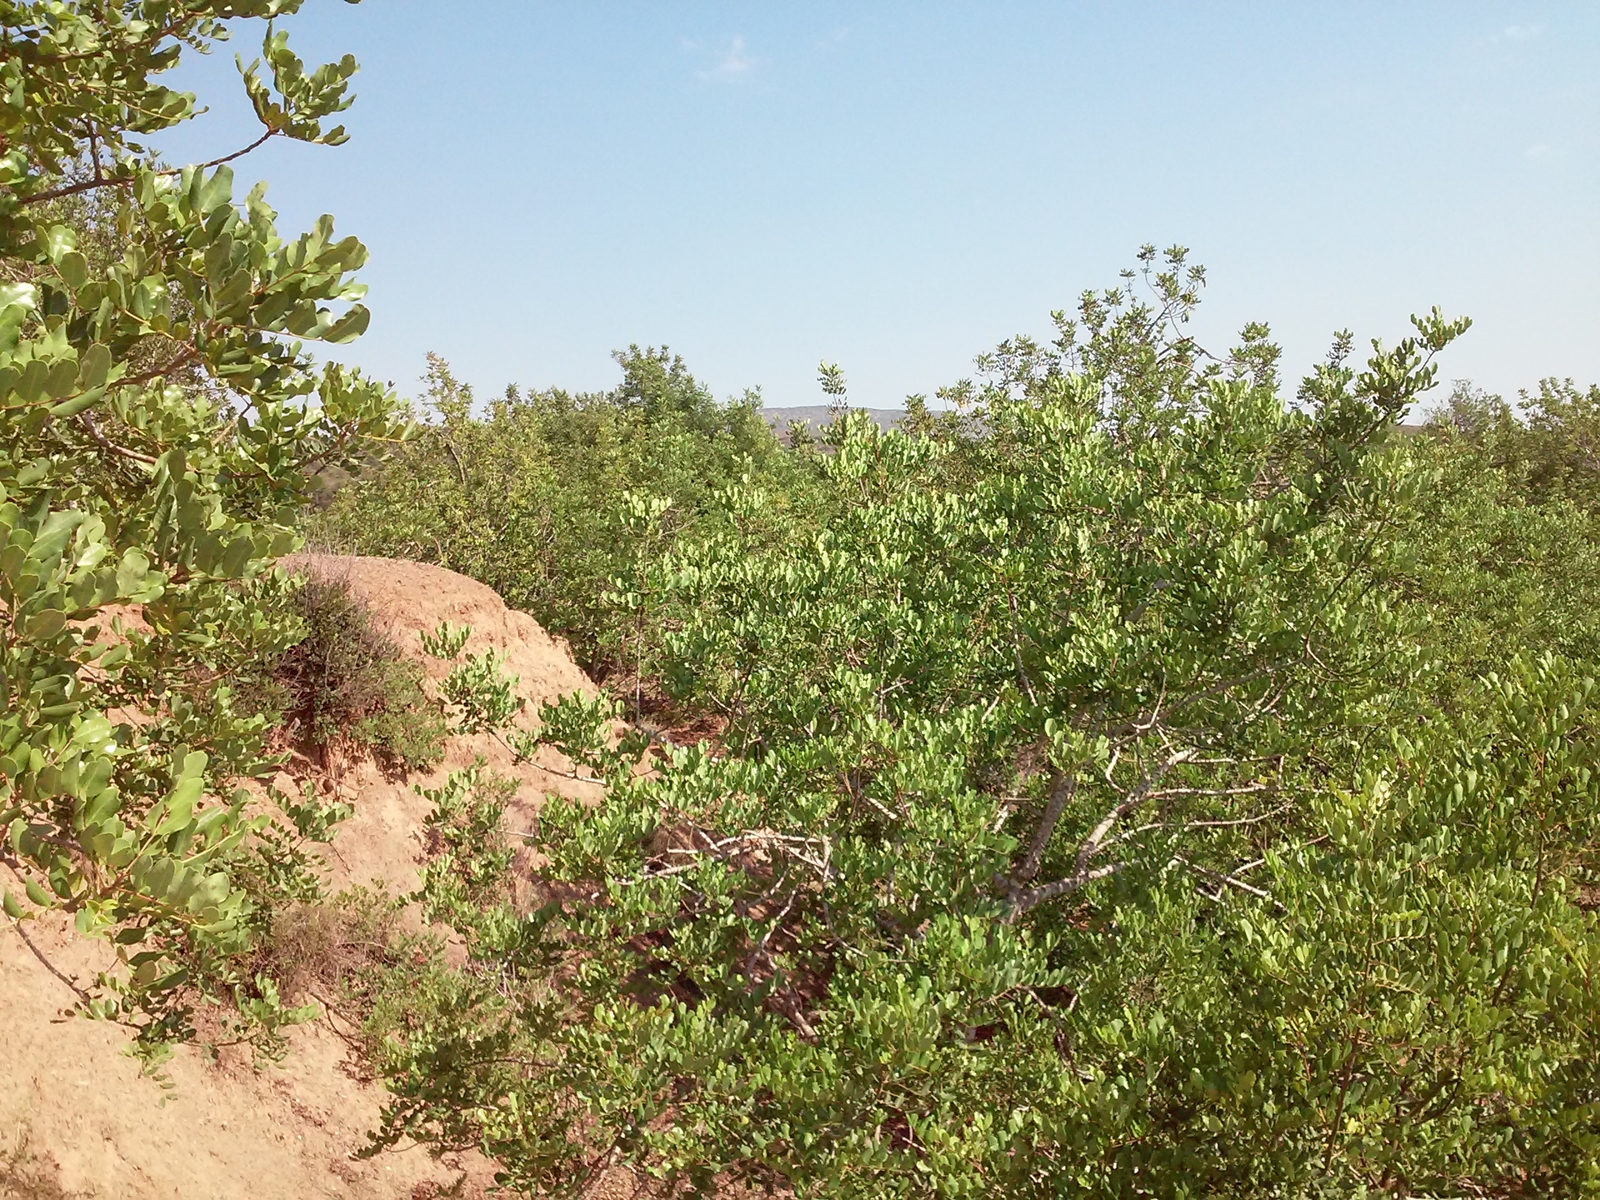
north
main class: Cropland
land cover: Permanent industrial crops
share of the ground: > 75 %
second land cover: Other bare soil
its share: > 75 %
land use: Agriculture (excluding fallow land and kitchen gardens)
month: June
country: ES
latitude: 41.2909
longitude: 1.2158
